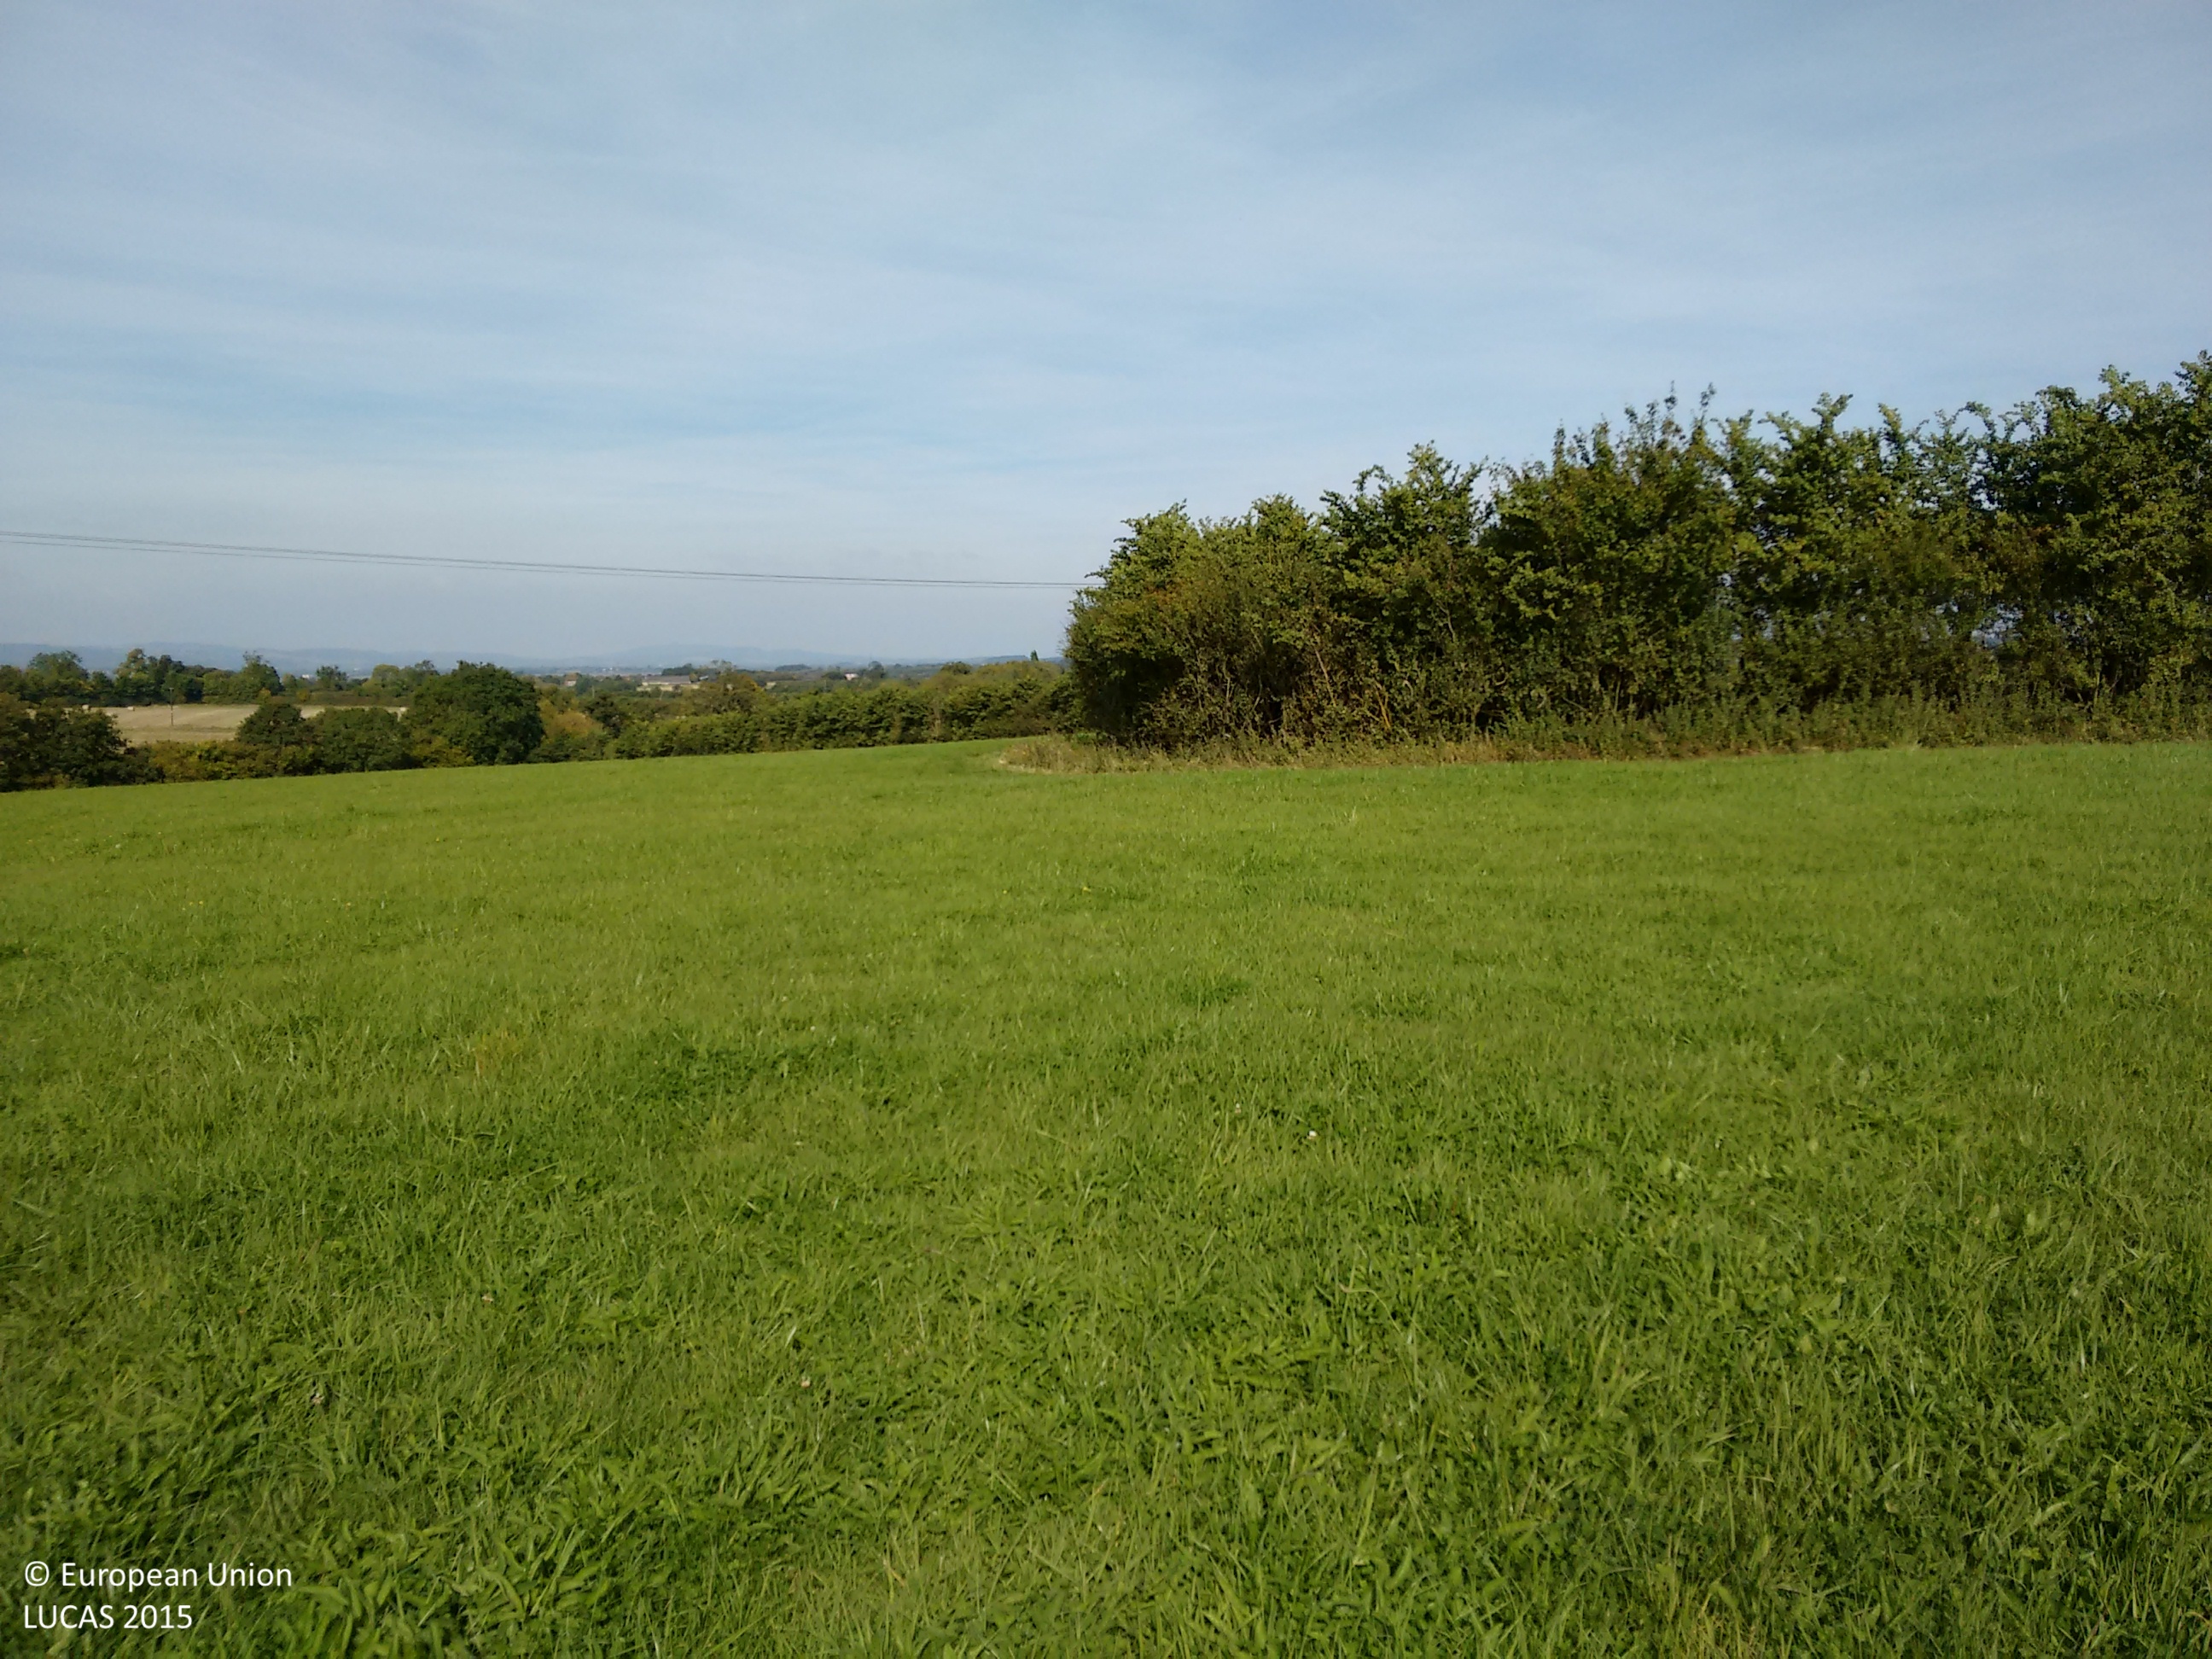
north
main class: Grassland
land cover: Grassland without tree/shrub cover
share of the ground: > 75 %
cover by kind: herbaceous plants 100 %
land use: Agriculture (excluding fallow land and kitchen gardens)
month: September
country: GB
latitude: 51.7051
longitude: -2.4085
